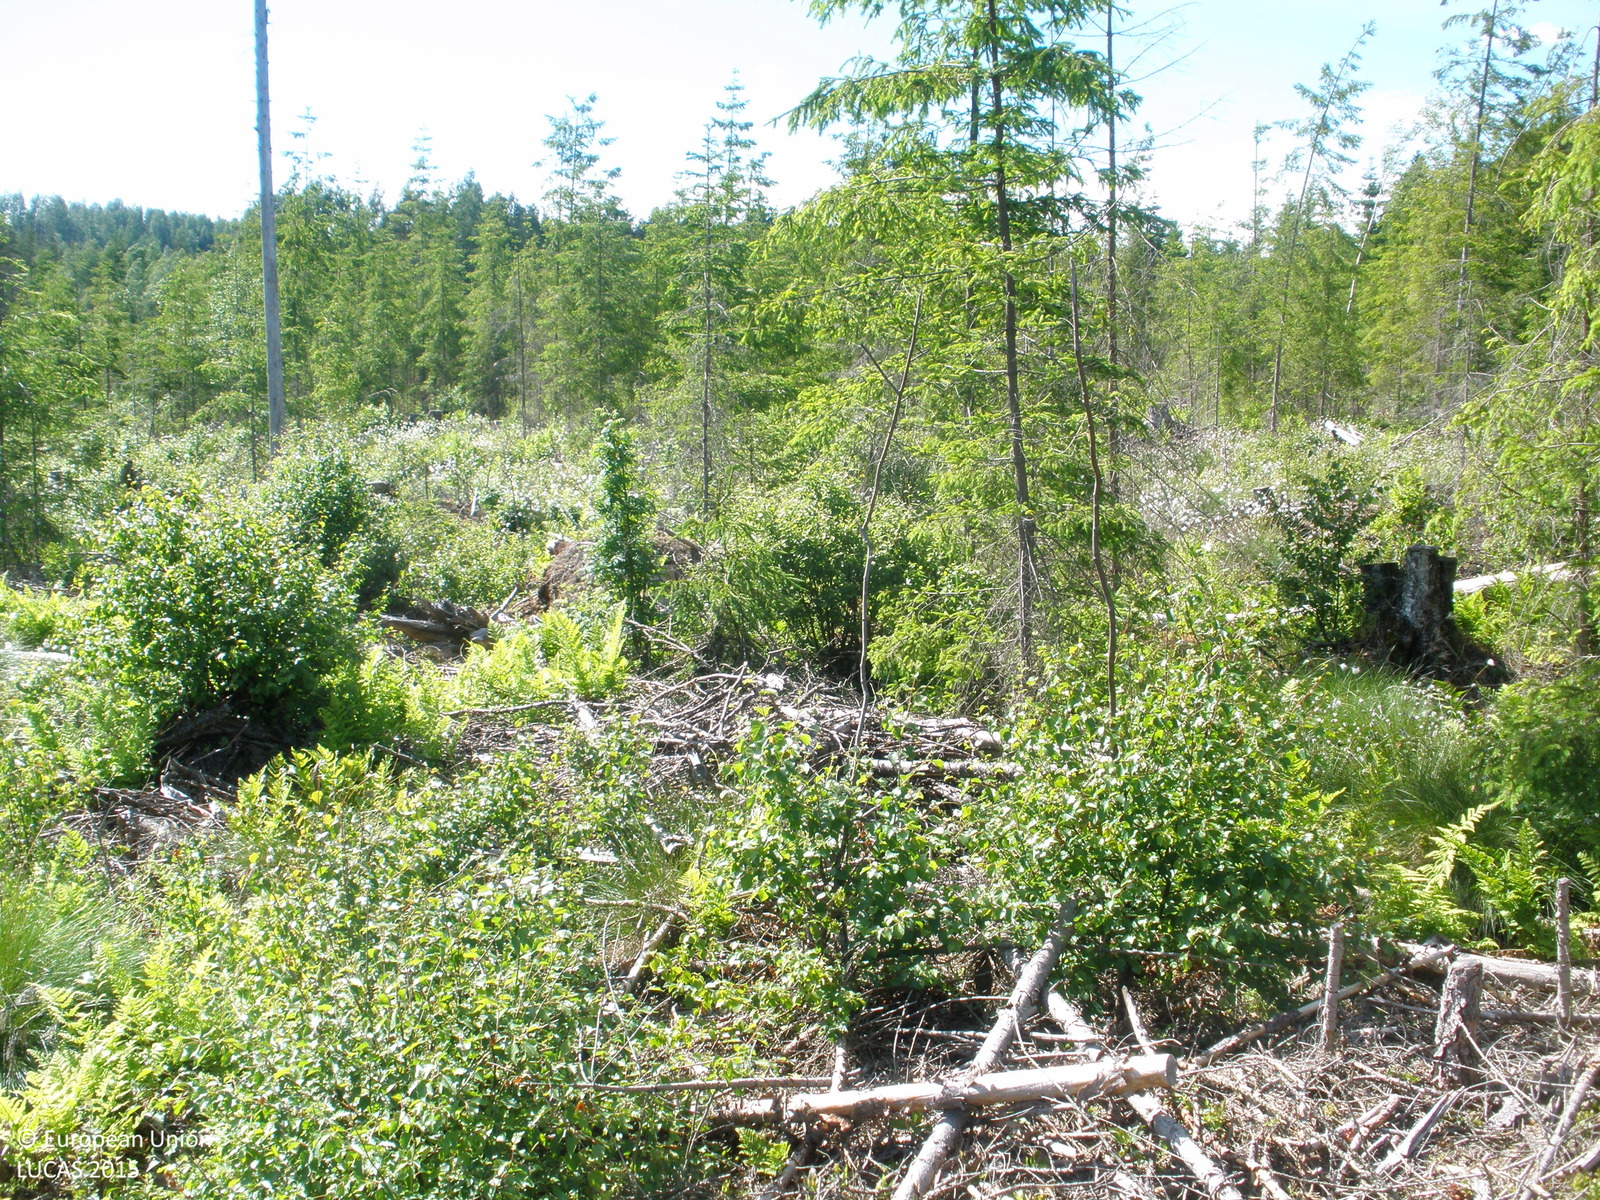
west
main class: Woodland
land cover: Spruce dominated mixed woodland
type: boreal forest
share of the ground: 50 - 75 %
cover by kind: coniferous forest trees 25 %, broadleaved forest trees 25 %, unconsolidated bare surface 25 %, herbaceous plants 10 %, consolidated bare surface 10 %
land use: Forestry
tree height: < 5 m
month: June
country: FI
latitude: 61.0628
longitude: 24.6493
